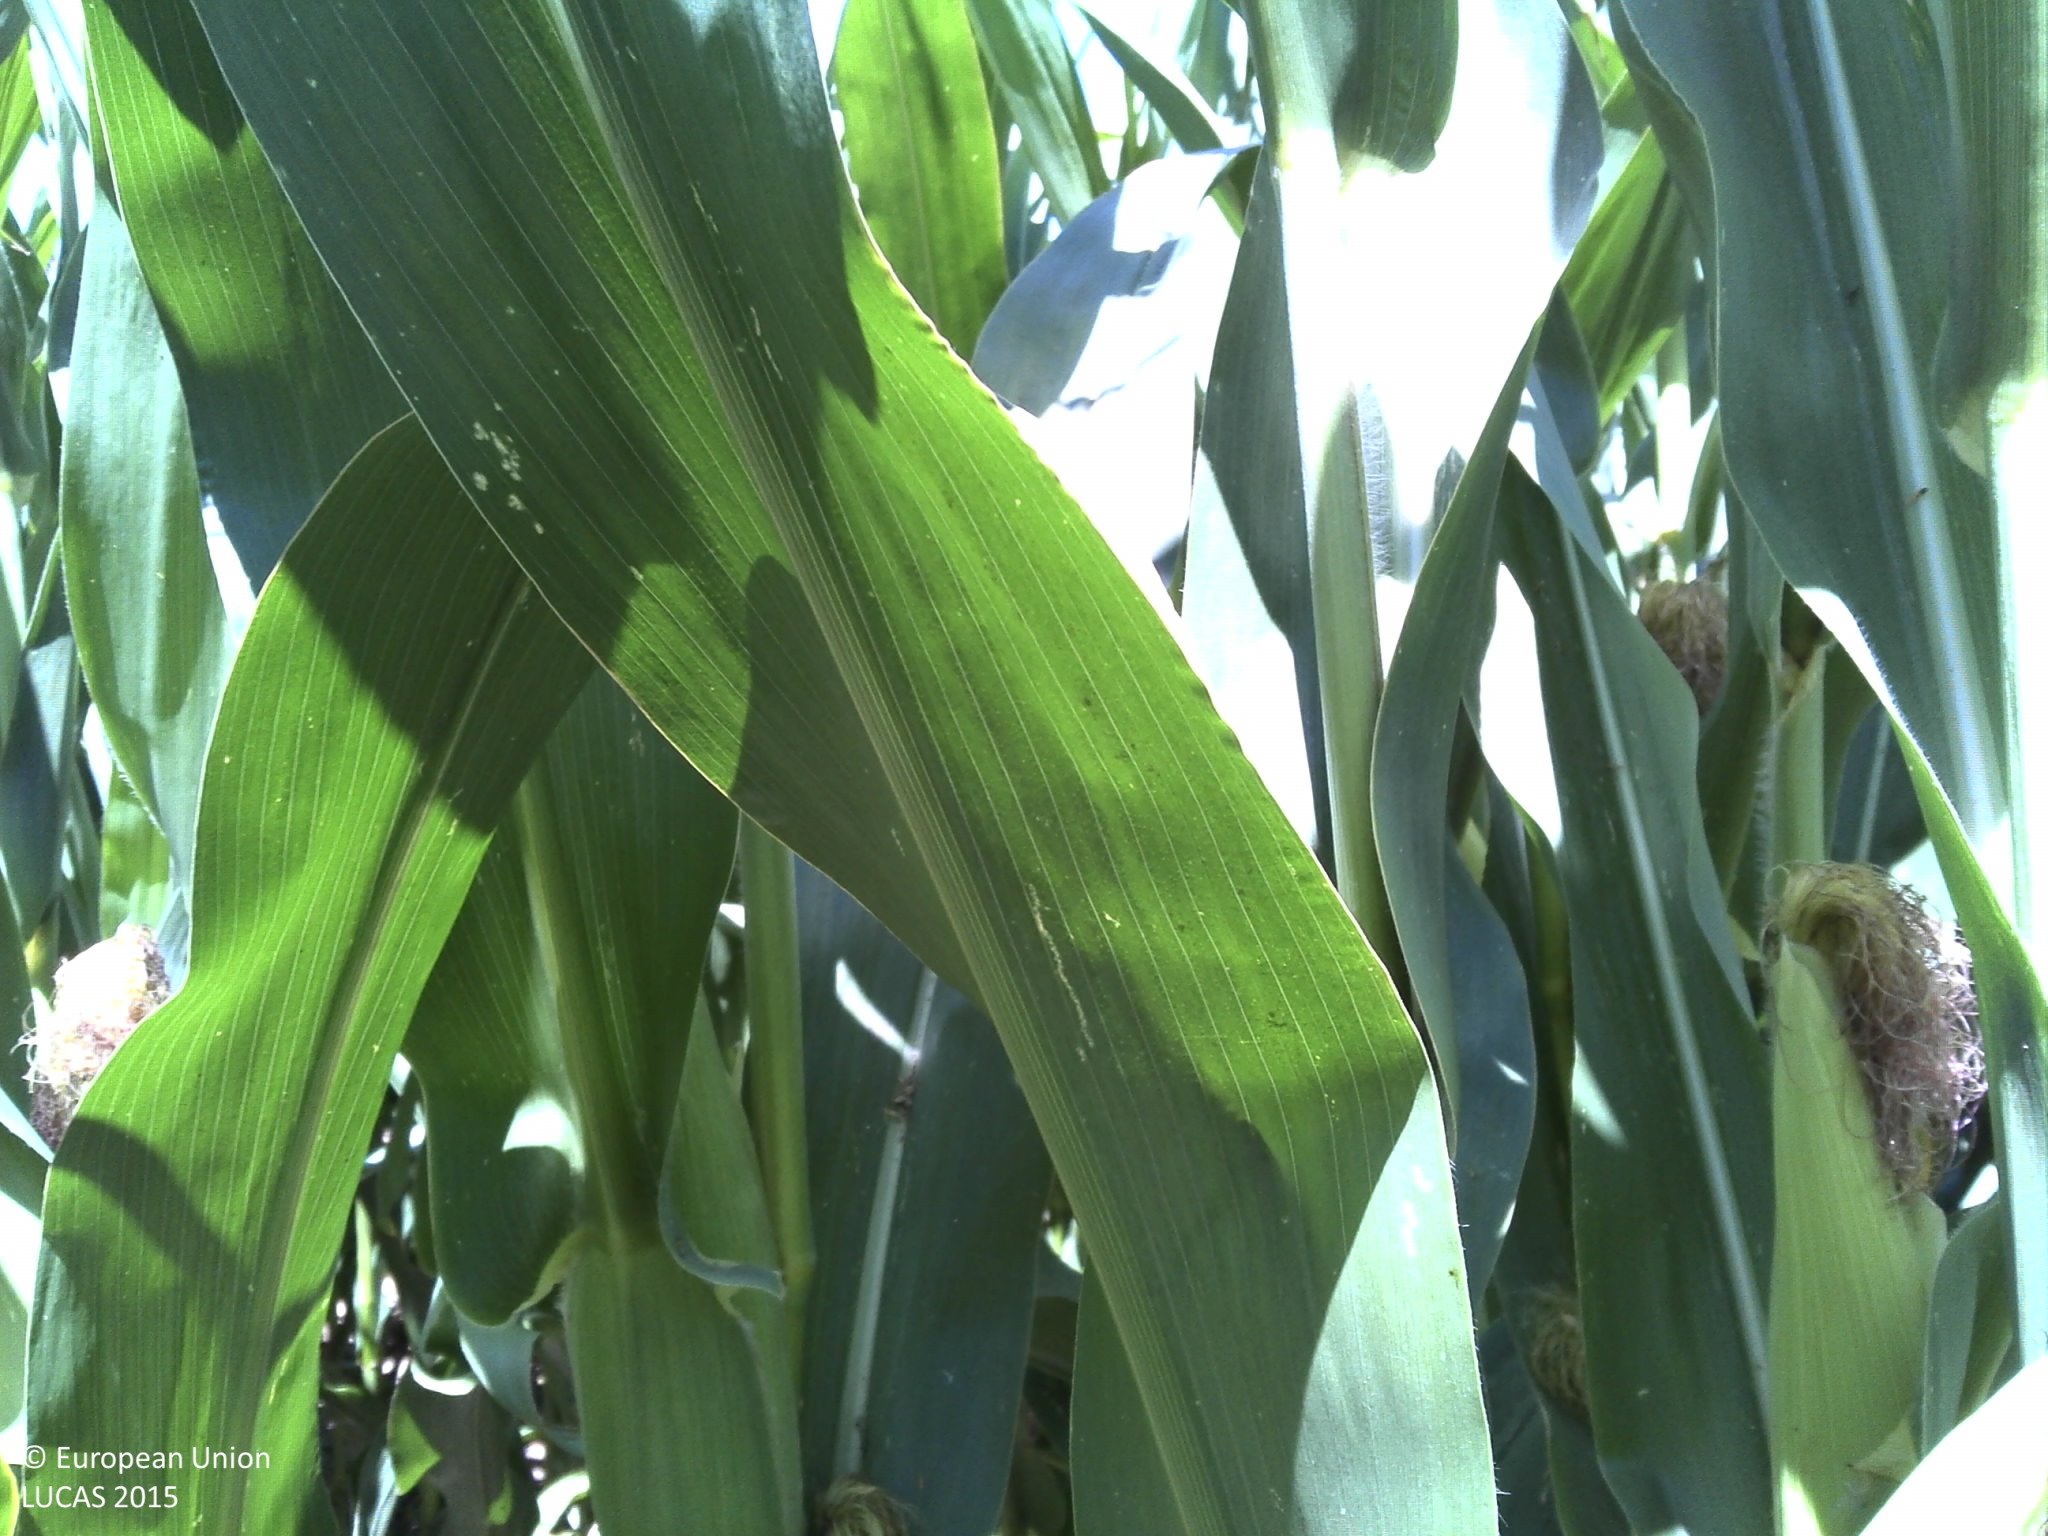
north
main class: Cropland
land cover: Maize
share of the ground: > 75 %
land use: Agriculture (excluding fallow land and kitchen gardens)
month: July
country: FR
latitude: 45.4841
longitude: -1.0685
